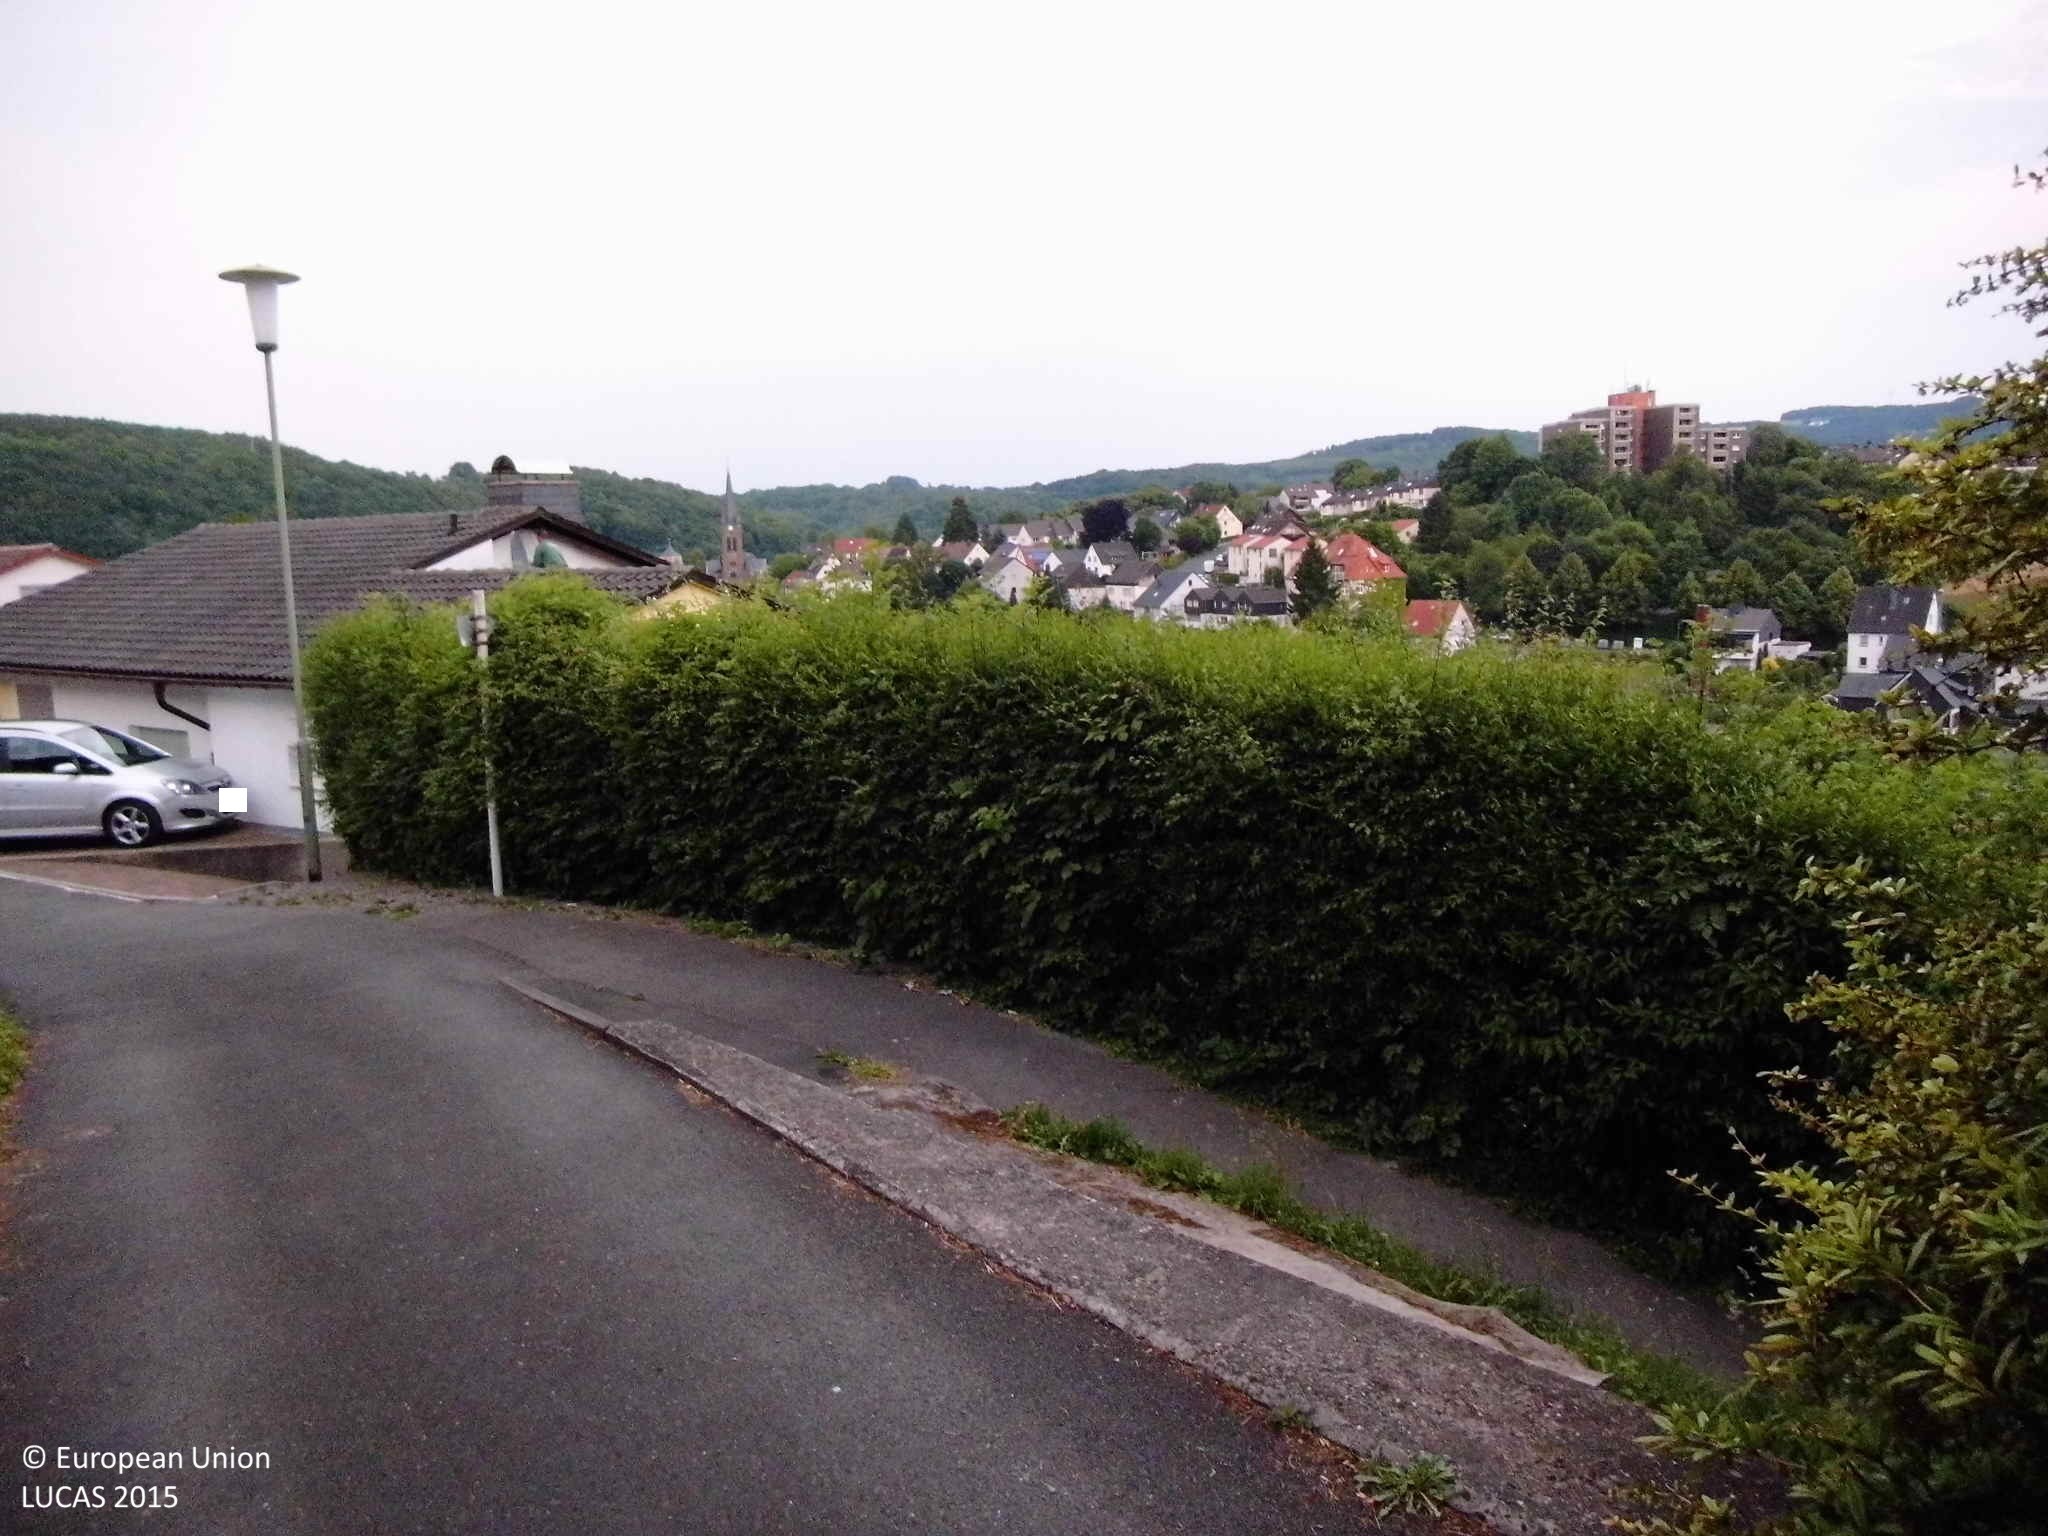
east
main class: Woodland
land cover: Other coniferous woodland
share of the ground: > 75 %
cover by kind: coniferous forest trees 70 %, broadleaved forest trees 20 %, shrubs 5 %, herbaceous plants 5 %
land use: Residential
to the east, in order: Other coniferous woodland; Artificial constructions in urban areas
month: June
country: DE
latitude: 51.3438
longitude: 7.4879
